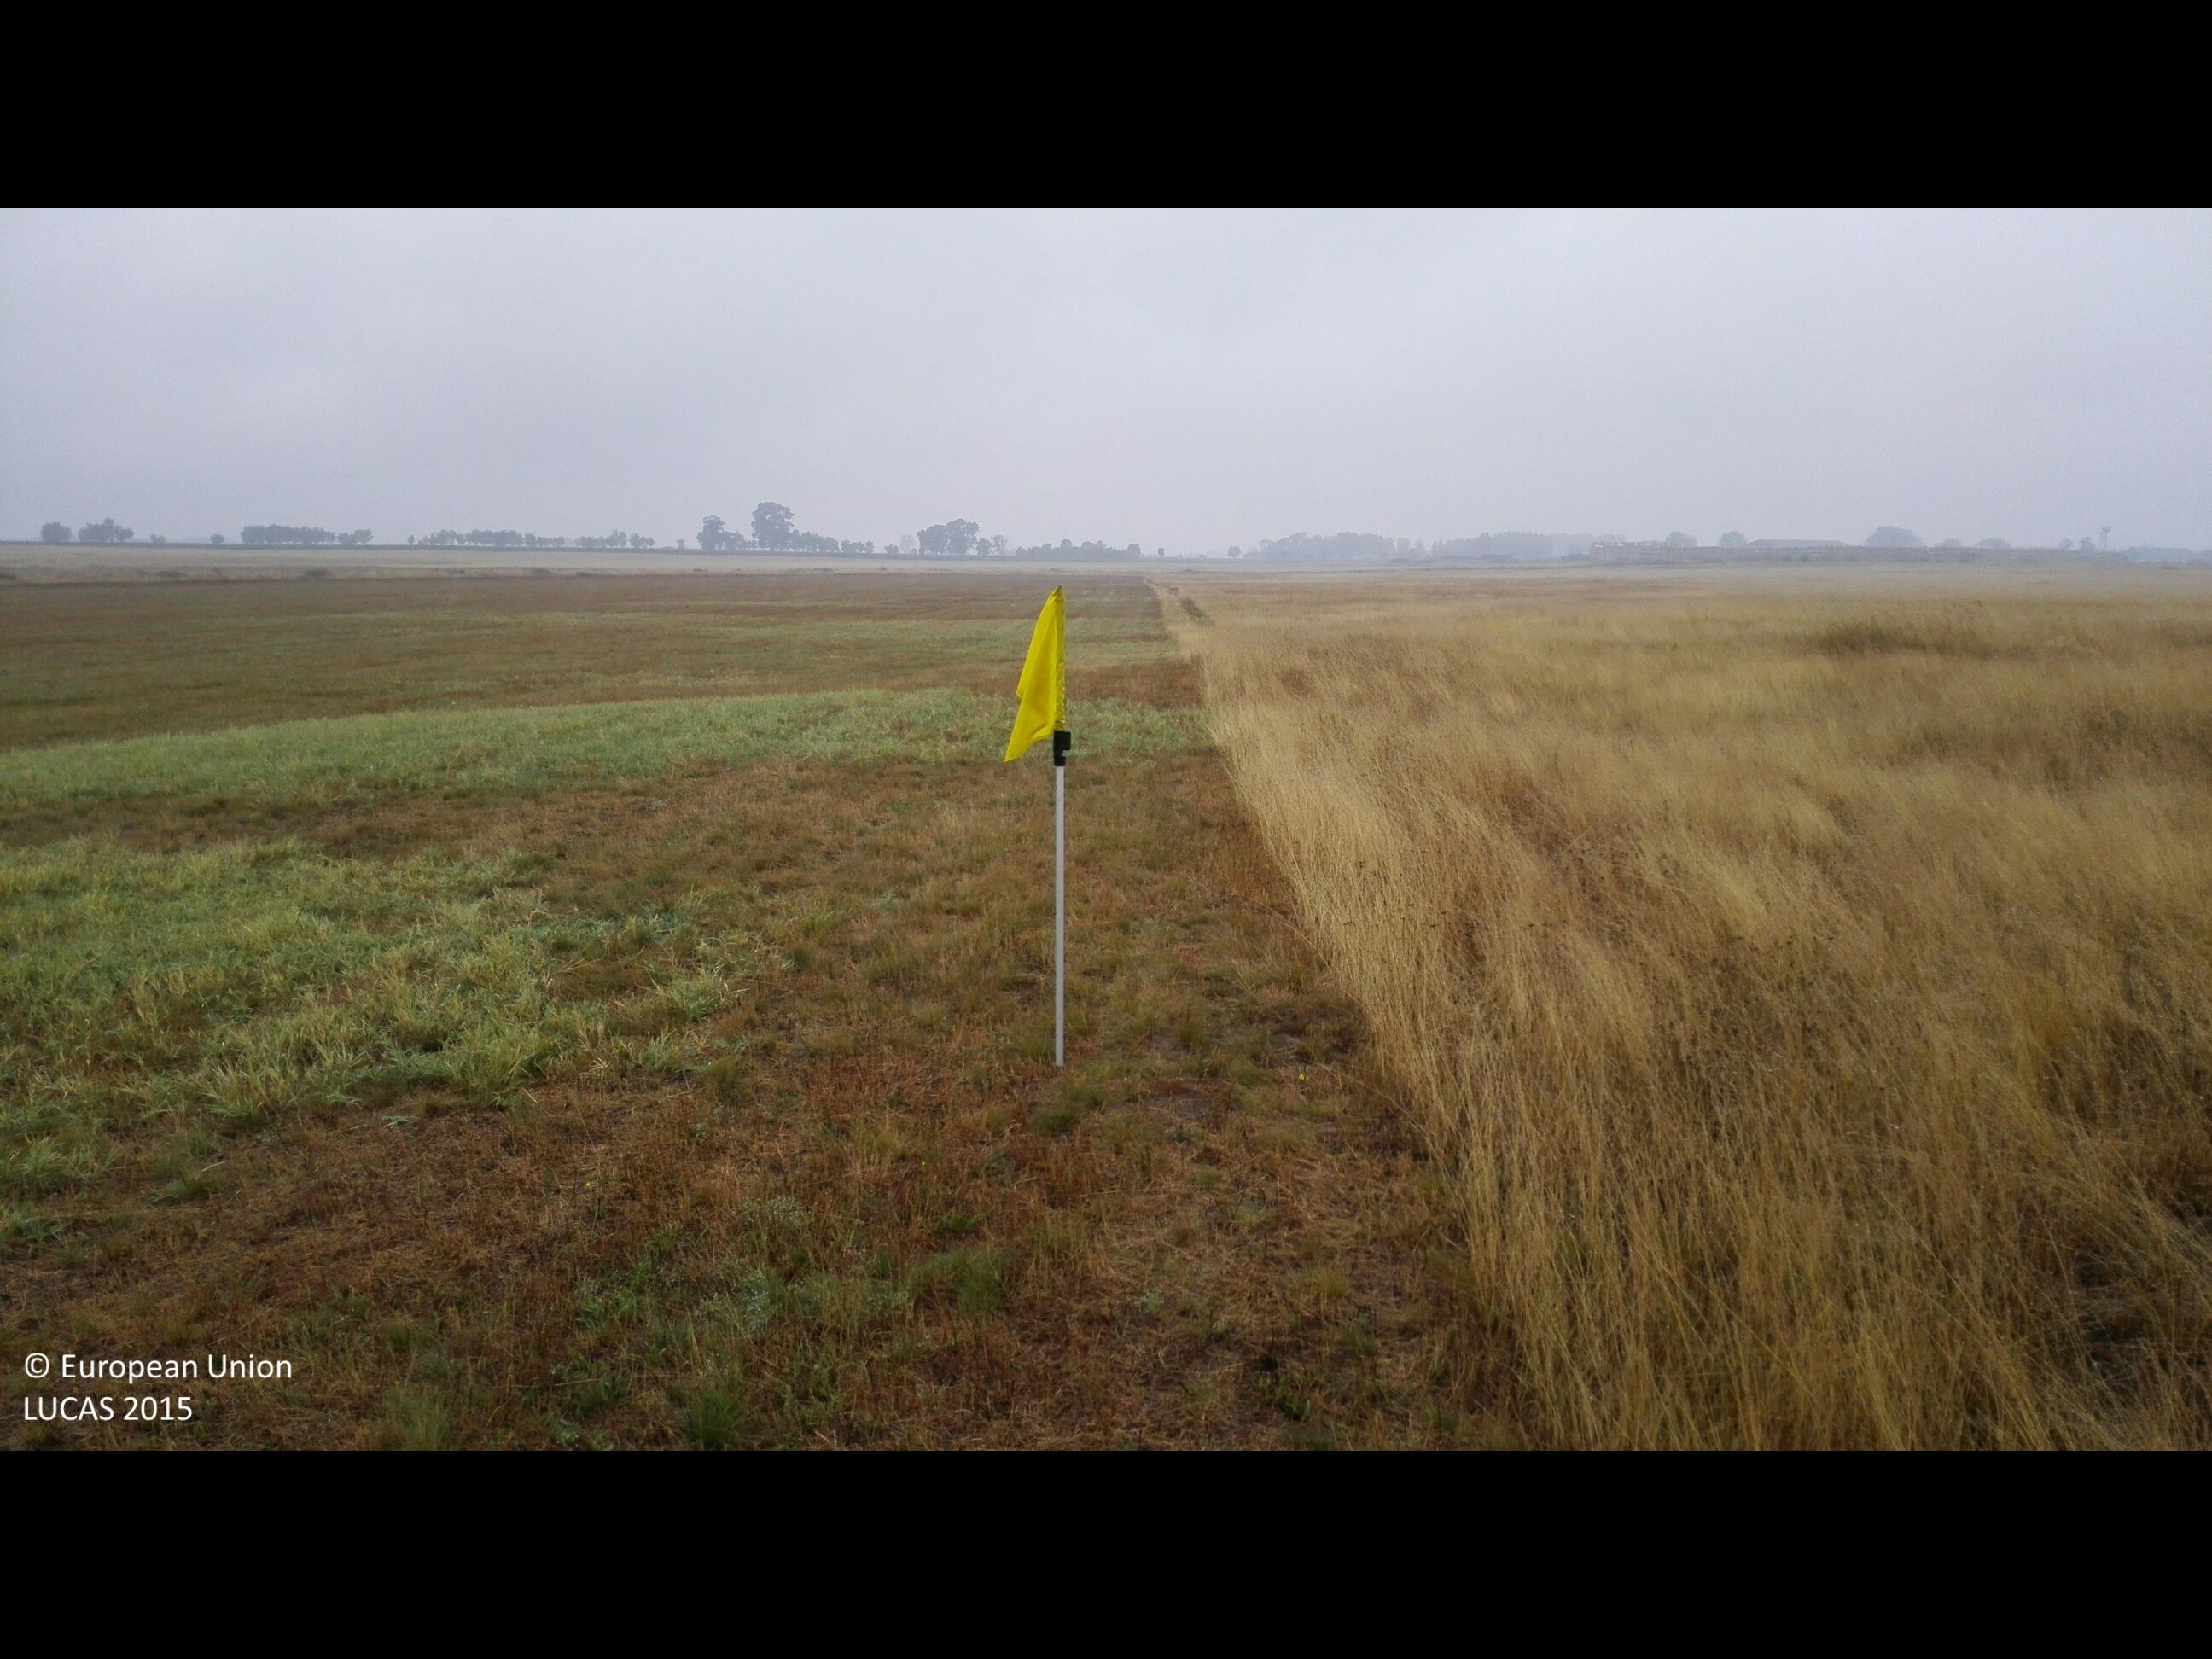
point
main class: Grassland
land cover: Grassland without tree/shrub cover
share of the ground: > 75 %
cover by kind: herbaceous plants 100 %
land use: Agriculture (excluding fallow land and kitchen gardens)
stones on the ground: < 10 %
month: August
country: HU
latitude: 47.1767
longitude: 21.5609
